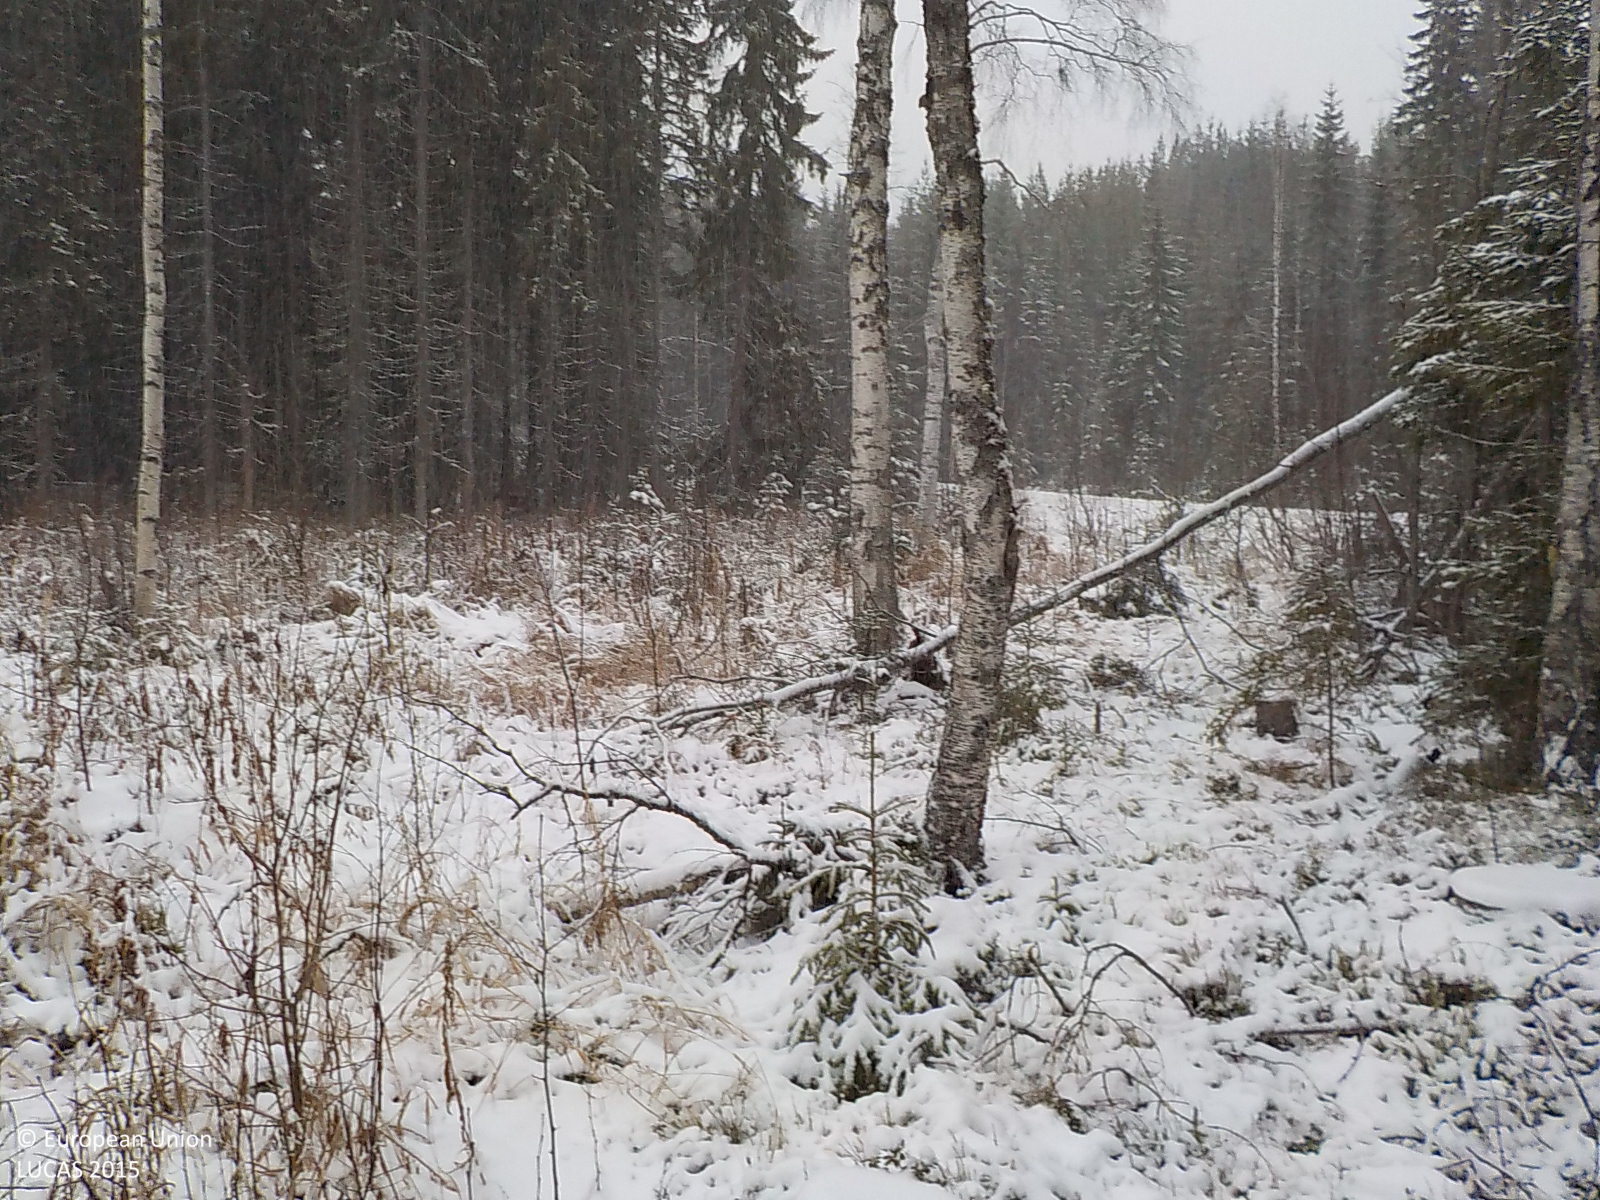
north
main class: Woodland
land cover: Other mixed woodland
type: boreal forest
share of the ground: 50 - 75 %
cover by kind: broadleaved forest trees 40 %, coniferous forest trees 30 %, herbaceous plants 30 %
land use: Forestry
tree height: > 5 m
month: December
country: SE
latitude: 63.3020
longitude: 16.9773
